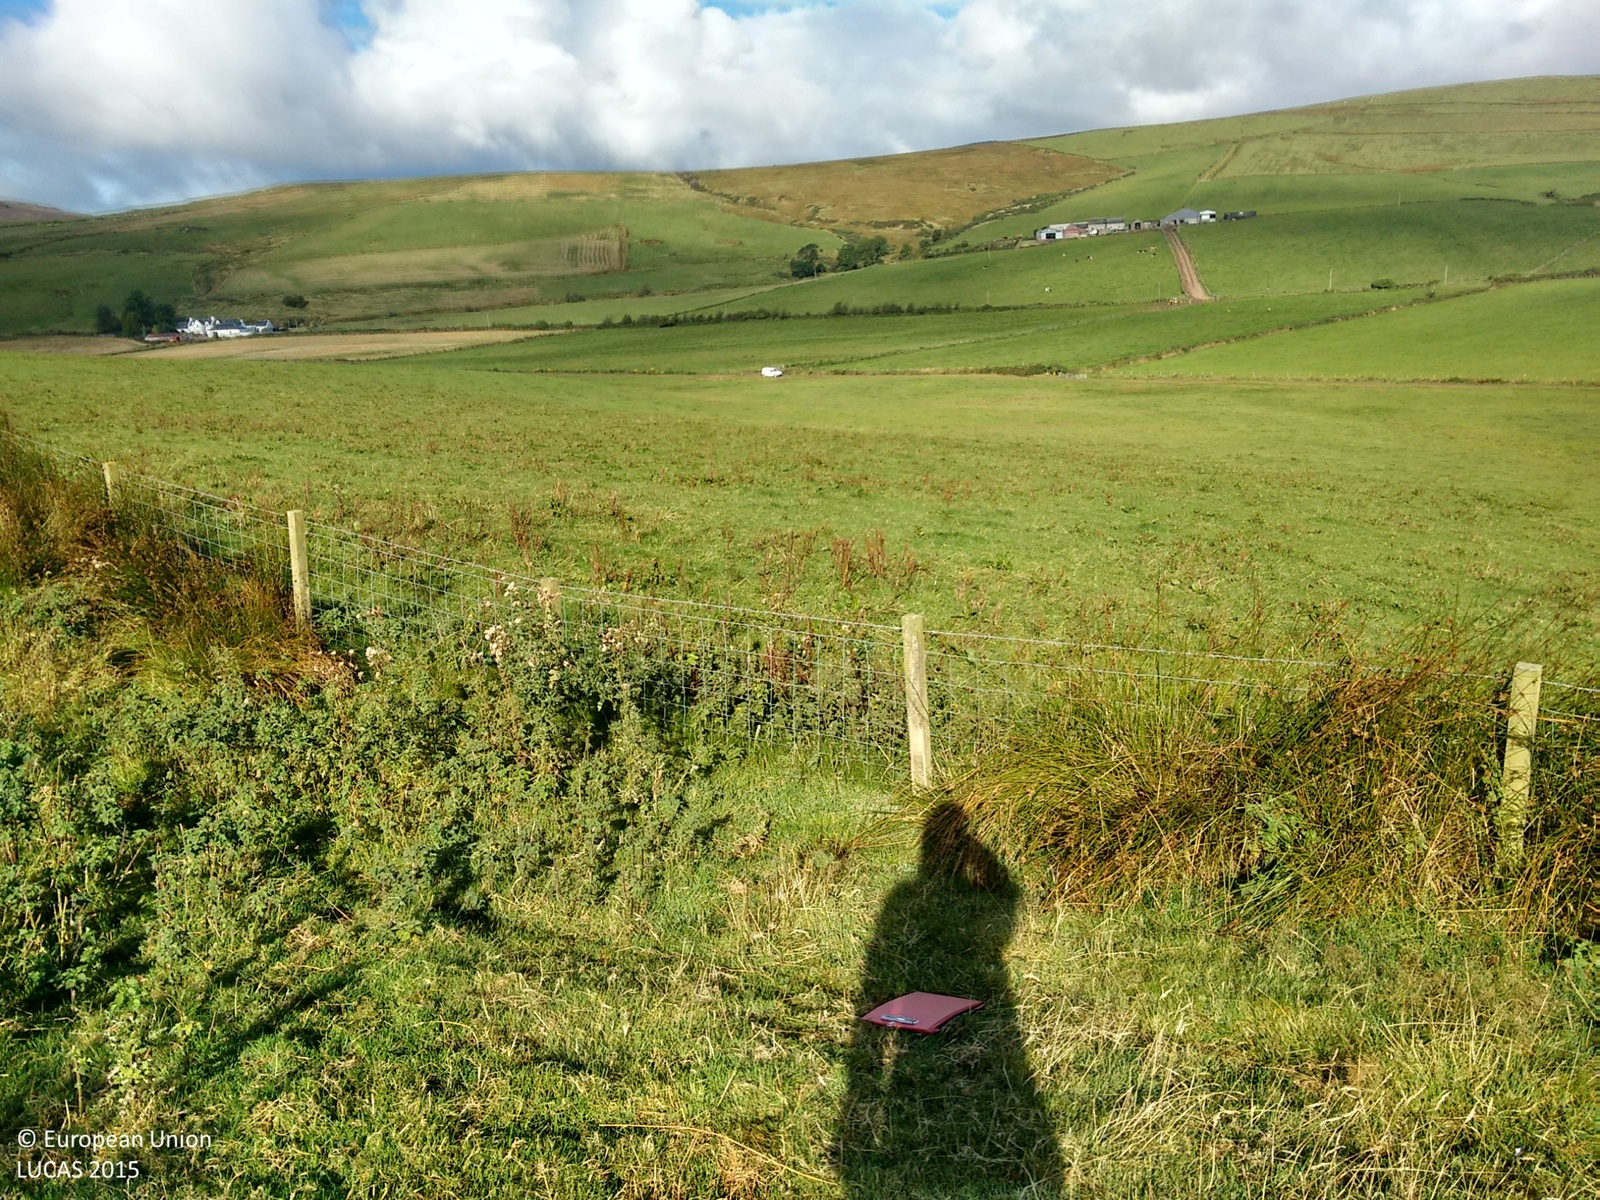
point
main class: Grassland
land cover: Grassland without tree/shrub cover
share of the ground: > 75 %
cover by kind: herbaceous plants 100 %
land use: Agriculture (excluding fallow land and kitchen gardens)
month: September
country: GB
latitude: 55.3281
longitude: -5.6547
